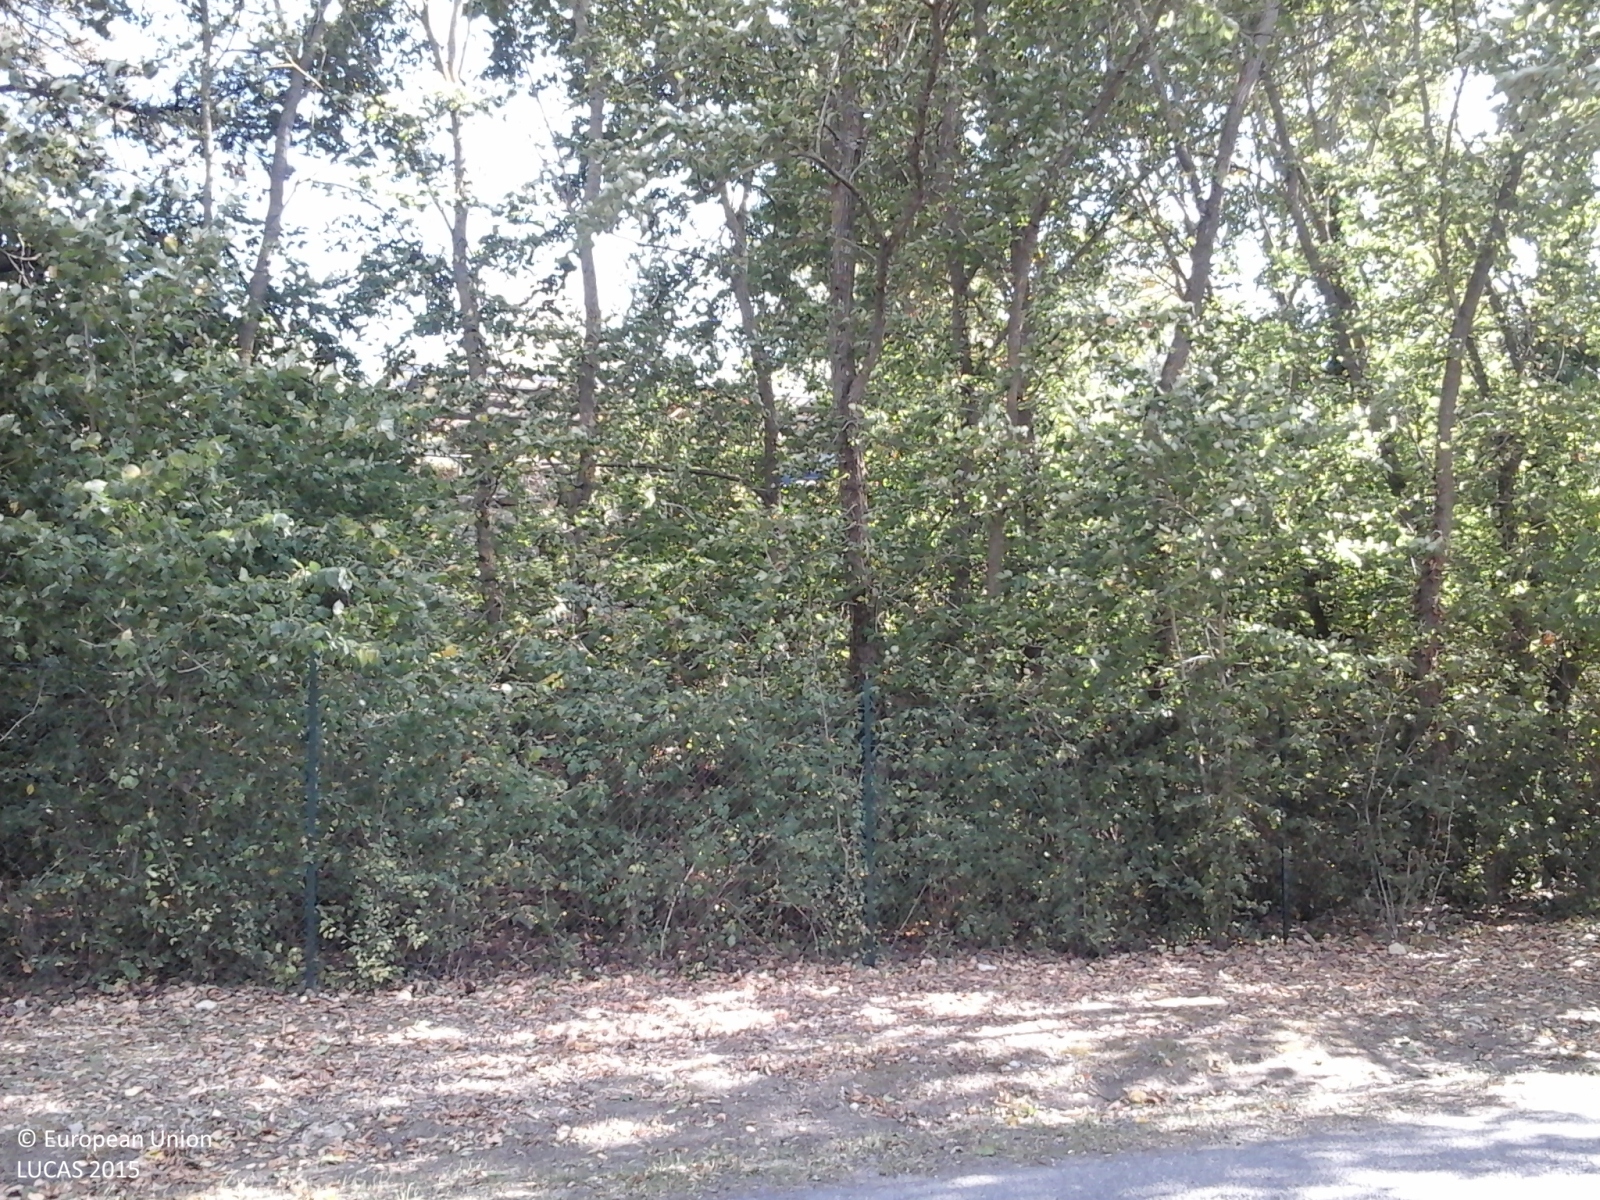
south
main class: Grassland
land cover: Grassland without tree/shrub cover
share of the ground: > 75 %
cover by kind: herbaceous plants 100 %
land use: Agriculture (excluding fallow land and kitchen gardens)
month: September
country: IT
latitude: 43.2082
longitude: 12.1969
